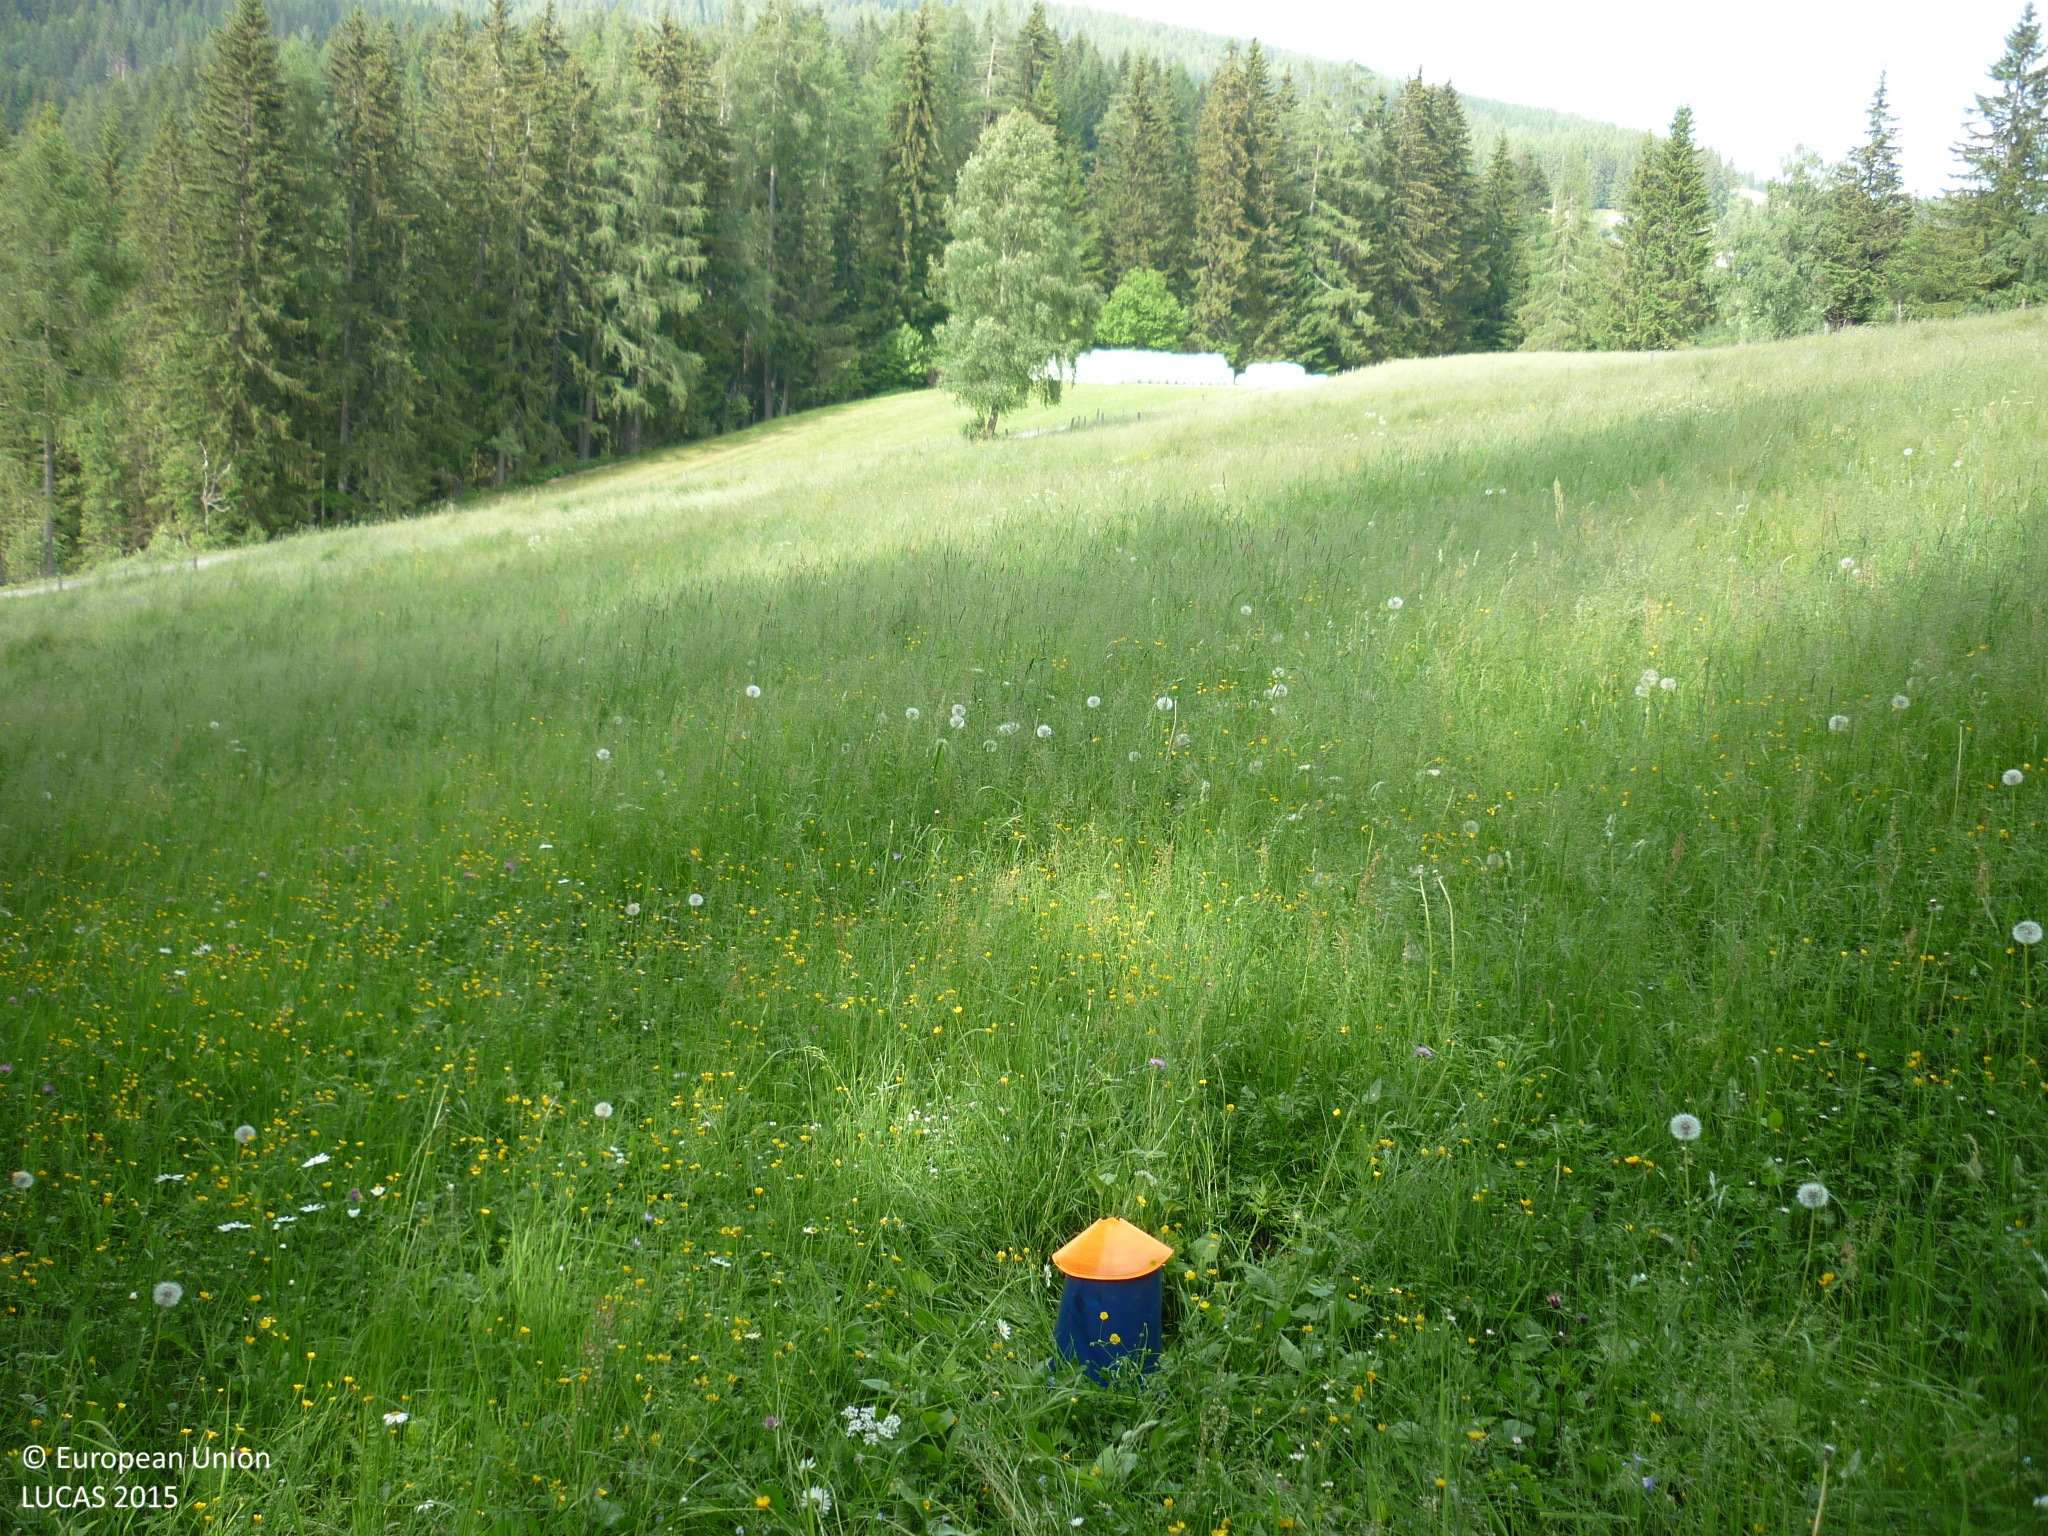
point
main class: Grassland
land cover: Grassland without tree/shrub cover
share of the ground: > 75 %
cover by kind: herbaceous plants 100 %
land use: Agriculture (excluding fallow land and kitchen gardens)
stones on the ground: < 10 %
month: June
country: AT
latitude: 47.2198
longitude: 14.3166
